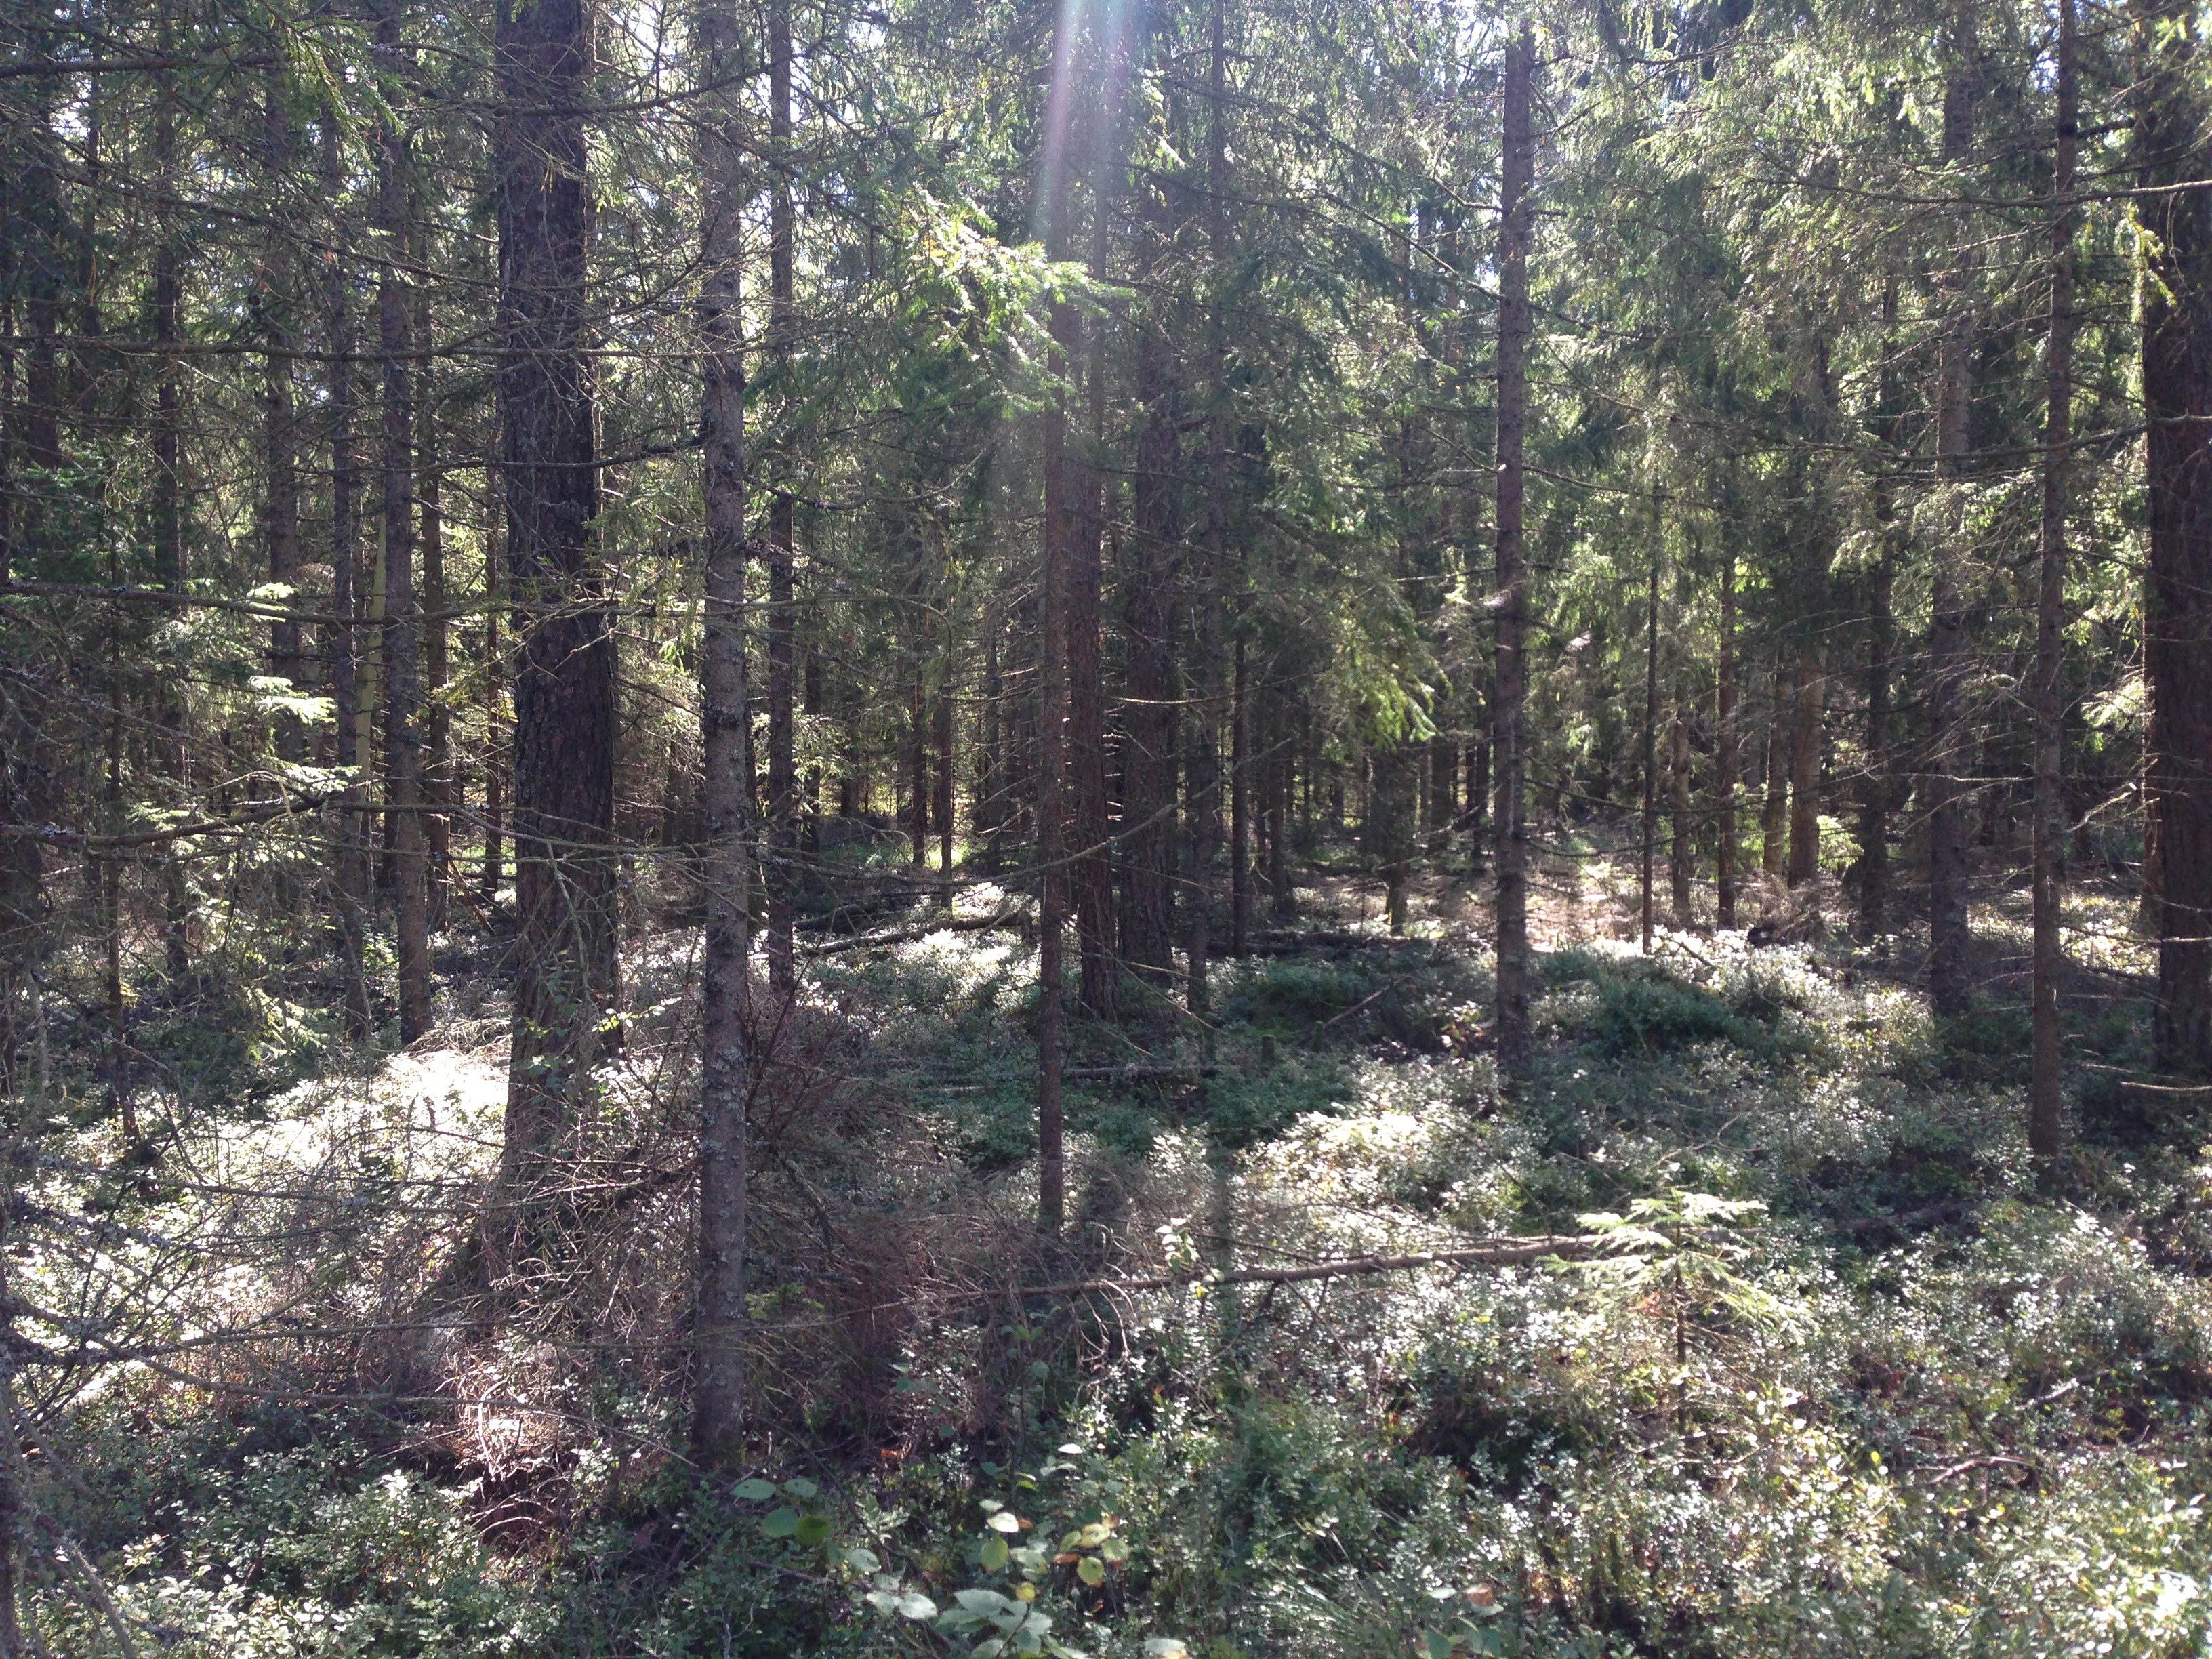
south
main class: Woodland
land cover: Pine dominated coniferous woodland
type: boreal forest
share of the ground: 50 - 75 %
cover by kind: coniferous forest trees 75 %, shrubs 25 %
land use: Forestry
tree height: > 5 m
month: September
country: SE
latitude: 57.1722
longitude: 13.2543
